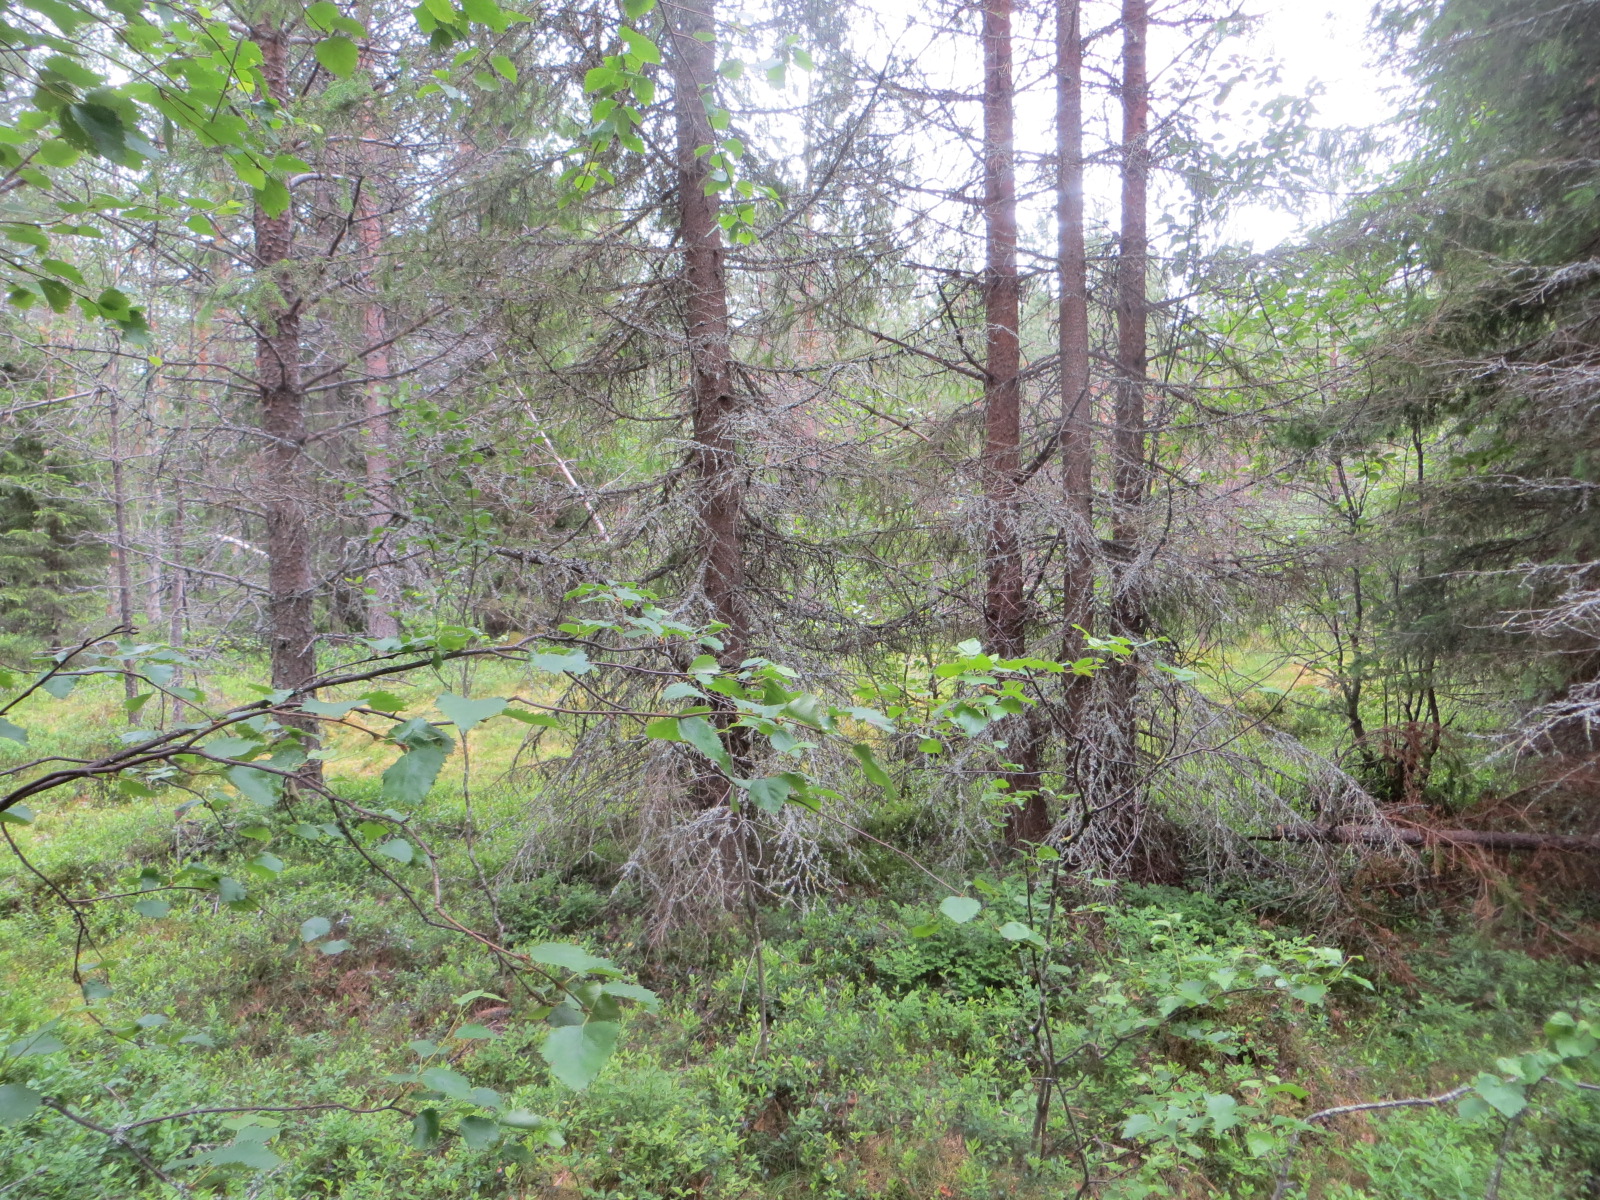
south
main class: Woodland
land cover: Other mixed woodland
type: boreal forest
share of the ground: > 75 %
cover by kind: coniferous forest trees 50 %, broadleaved forest trees 25 %, shrubs 25 %
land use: Forestry
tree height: > 5 m
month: July
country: FI
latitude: 65.7418
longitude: 25.2732
